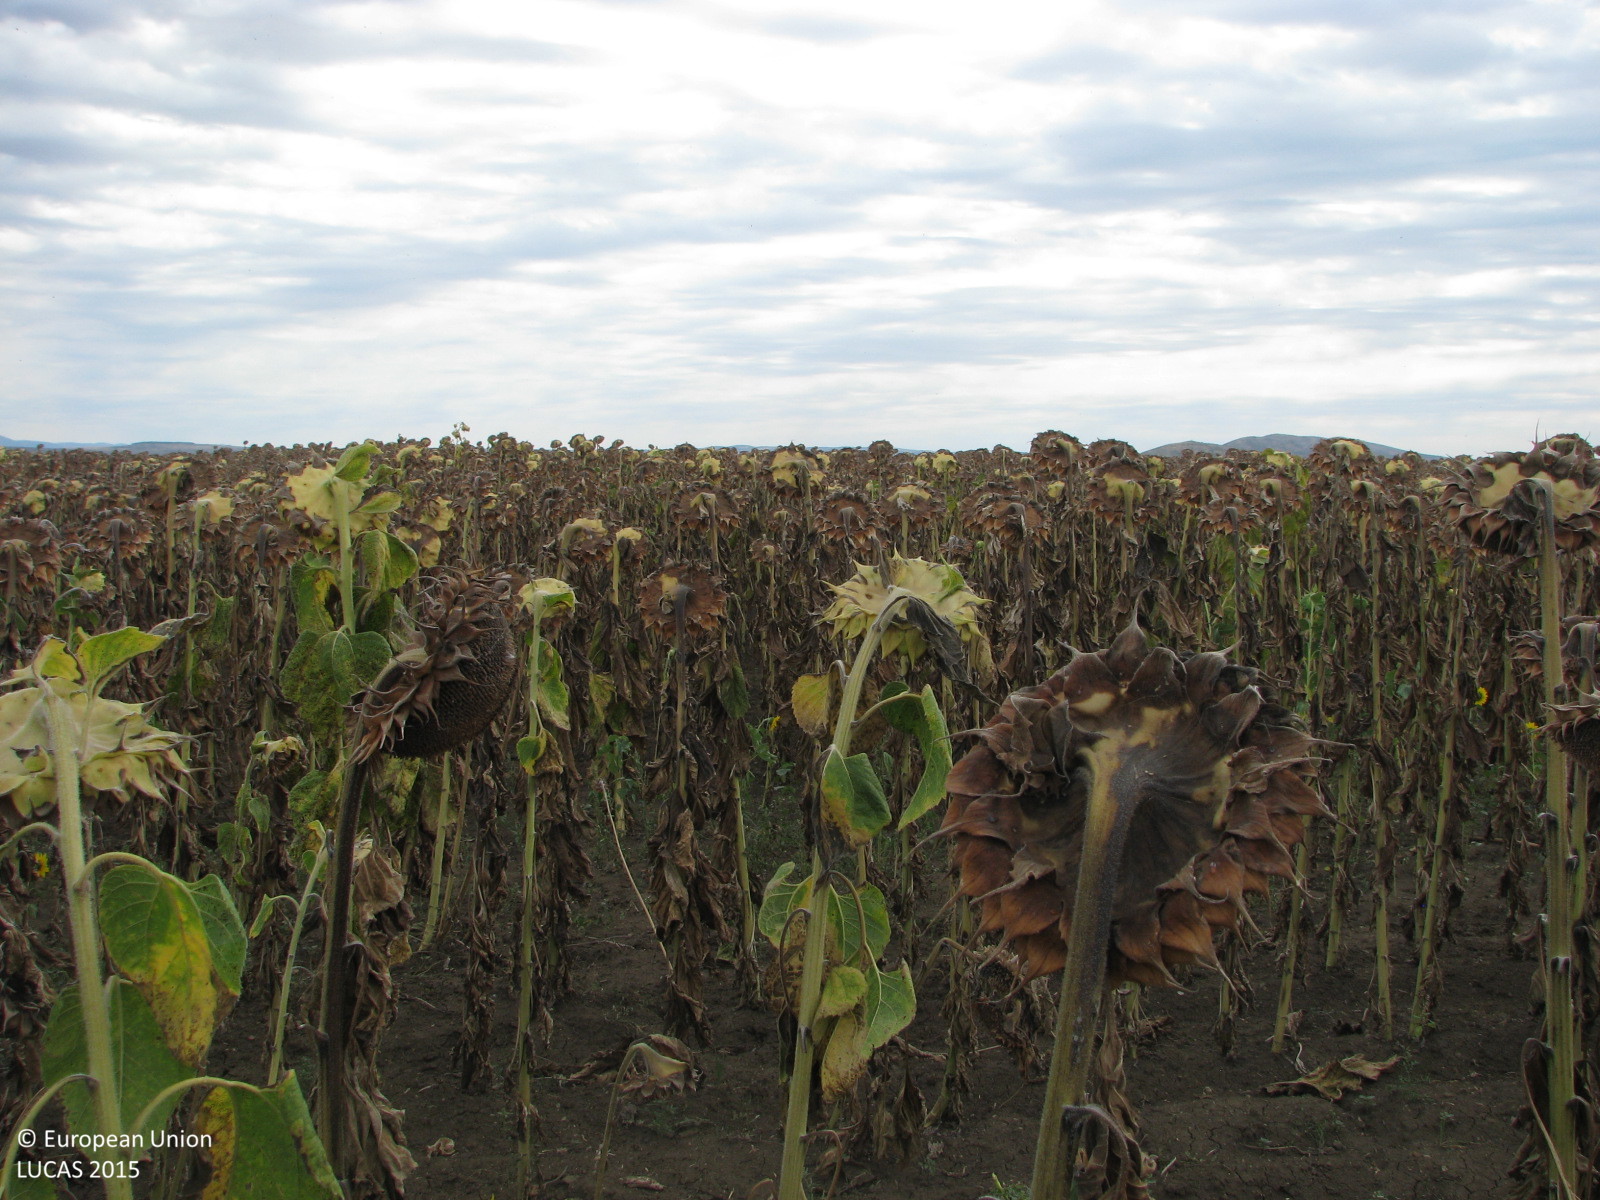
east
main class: Cropland
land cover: Sunflower
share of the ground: > 75 %
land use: Agriculture (excluding fallow land and kitchen gardens)
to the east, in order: Sunflower
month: September
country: BG
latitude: 42.5157
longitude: 26.0886
